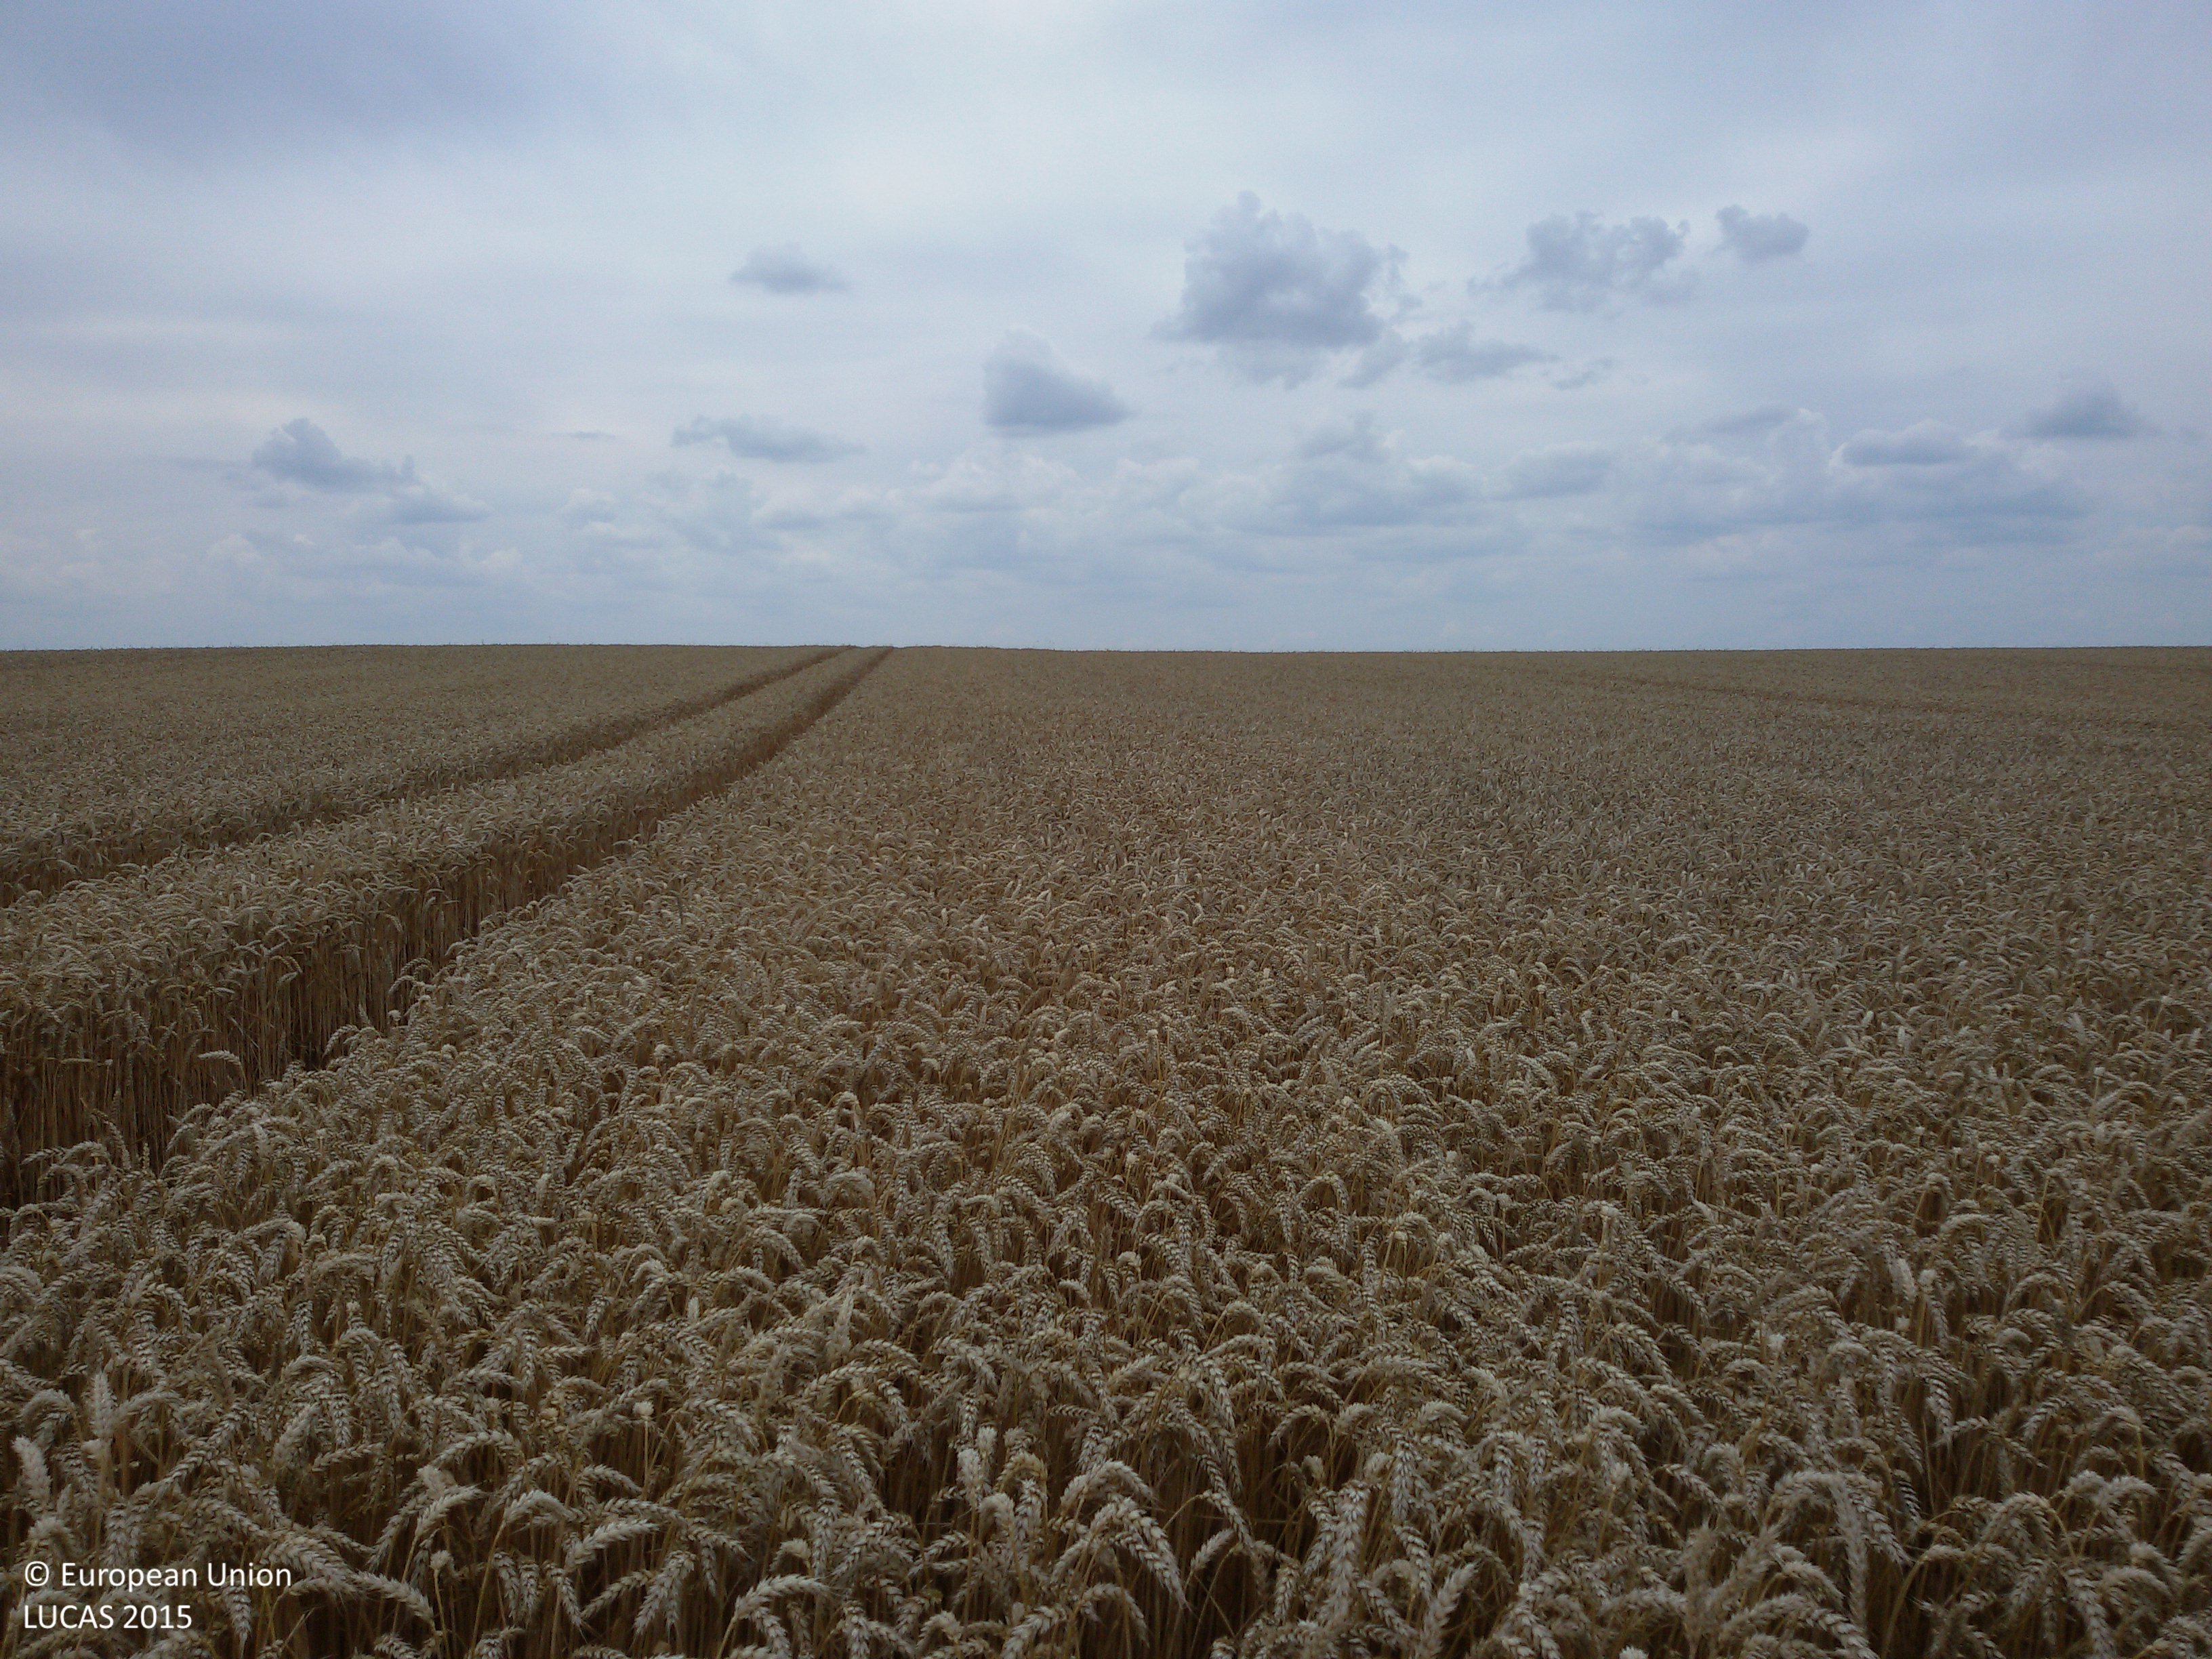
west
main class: Cropland
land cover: Common wheat
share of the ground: > 75 %
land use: Agriculture (excluding fallow land and kitchen gardens)
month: July
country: PL
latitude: 51.0777
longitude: 23.4578
